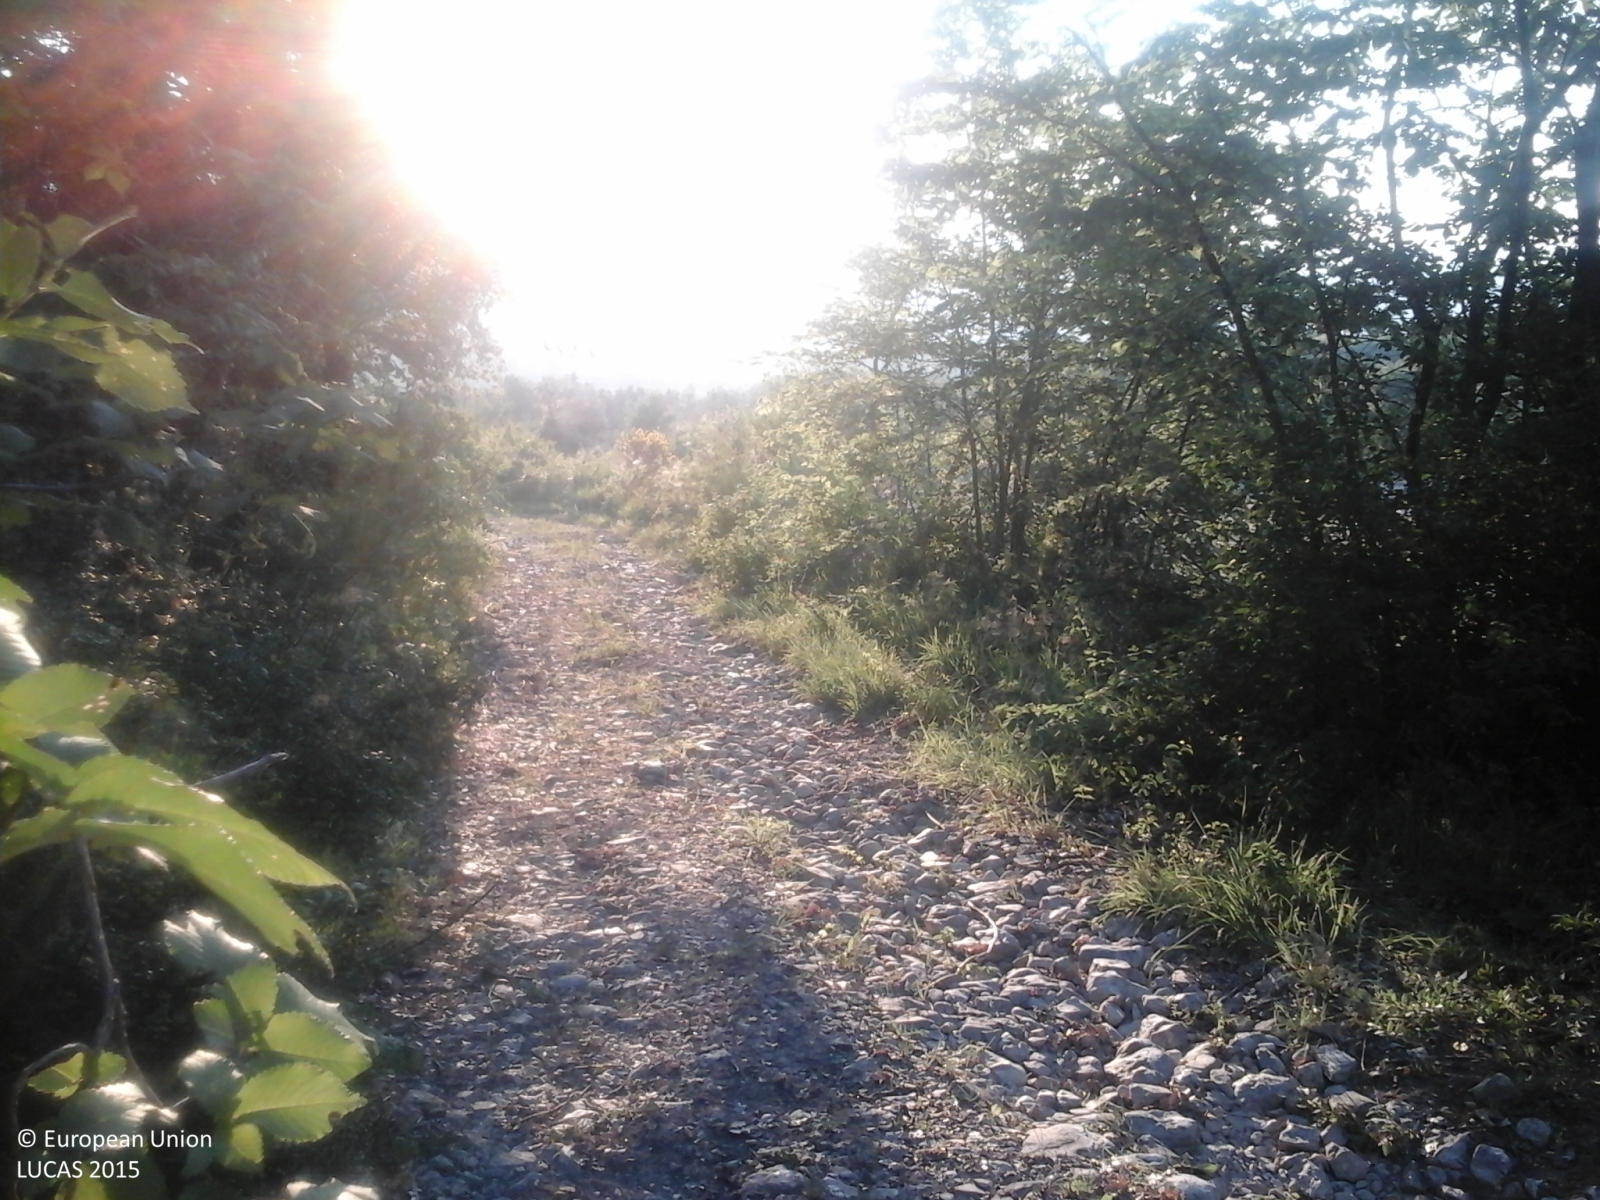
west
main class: Woodland
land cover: Broadleaved woodland
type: thermophilous deciduous forest
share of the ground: > 75 %
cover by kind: broadleaved forest trees 80 %, shrubs 10 %, herbaceous plants 10 %
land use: Forestry
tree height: < 5 m
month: June
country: IT
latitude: 42.0532
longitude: 14.3721
